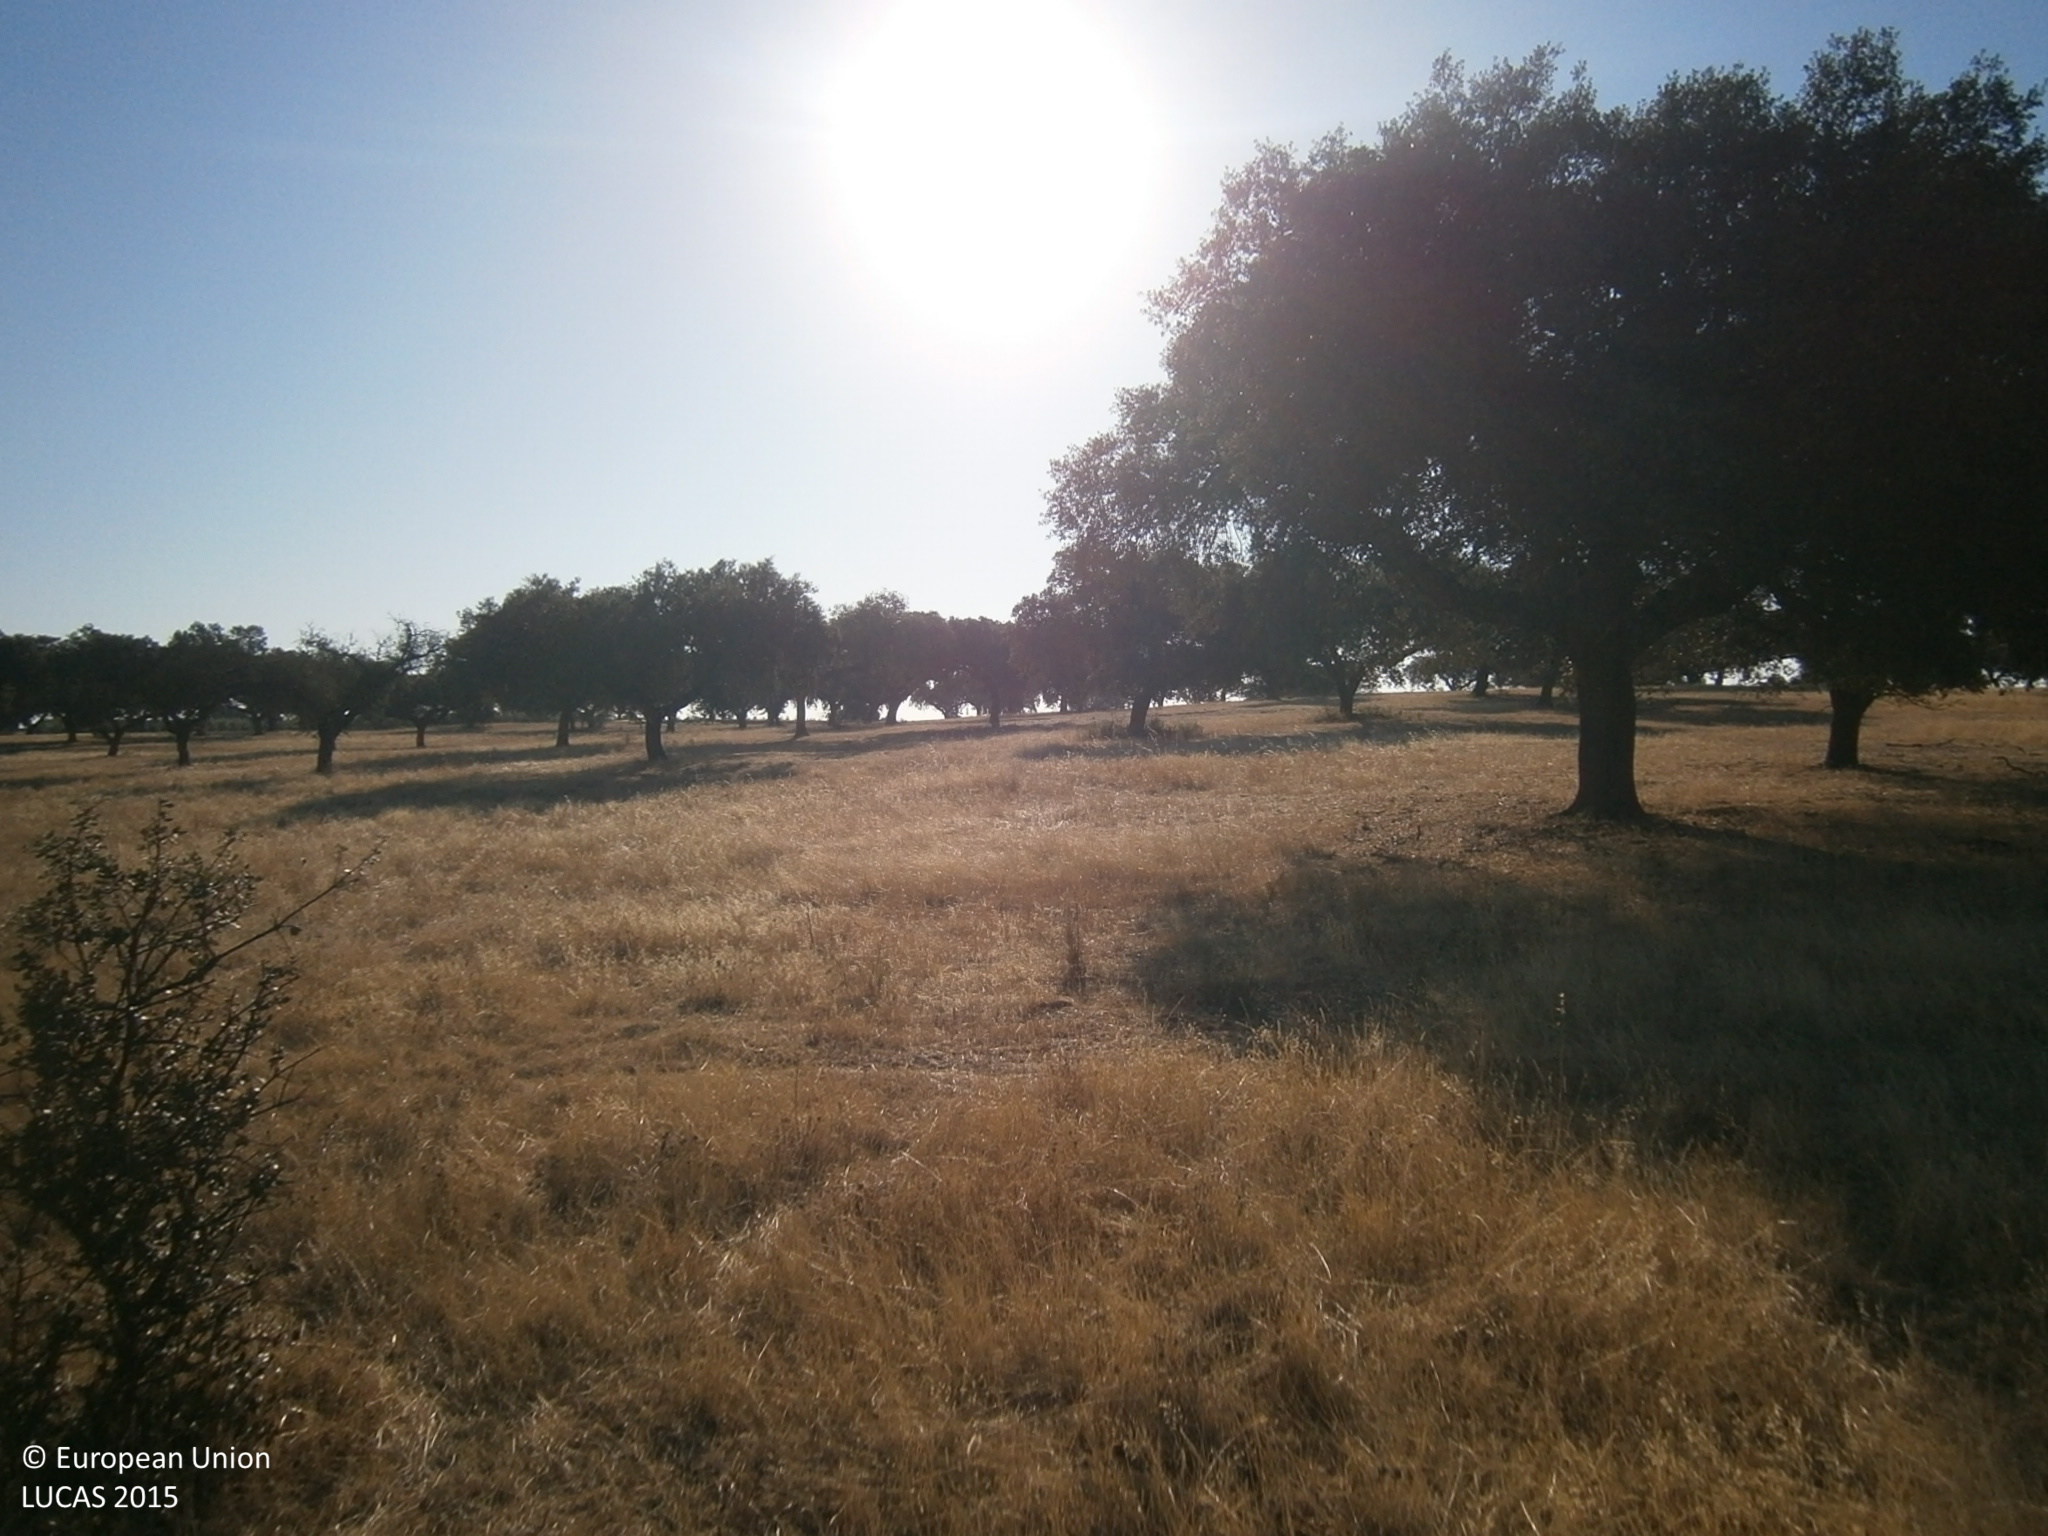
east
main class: Woodland
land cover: Broadleaved woodland
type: broadleaved evergreen forest
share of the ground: > 75 %
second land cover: Spontaneously vegetated surfaces
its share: > 75 %
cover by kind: broadleaved forest trees 90 %, shrubs 5 %
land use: Forestry
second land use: Agriculture (excluding fallow land and kitchen gardens)
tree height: > 5 m
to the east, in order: Broadleaved woodland; Spontaneously vegetated surfaces; Broadleaved woodland
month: July
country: ES
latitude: 38.9684
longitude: -6.7207
